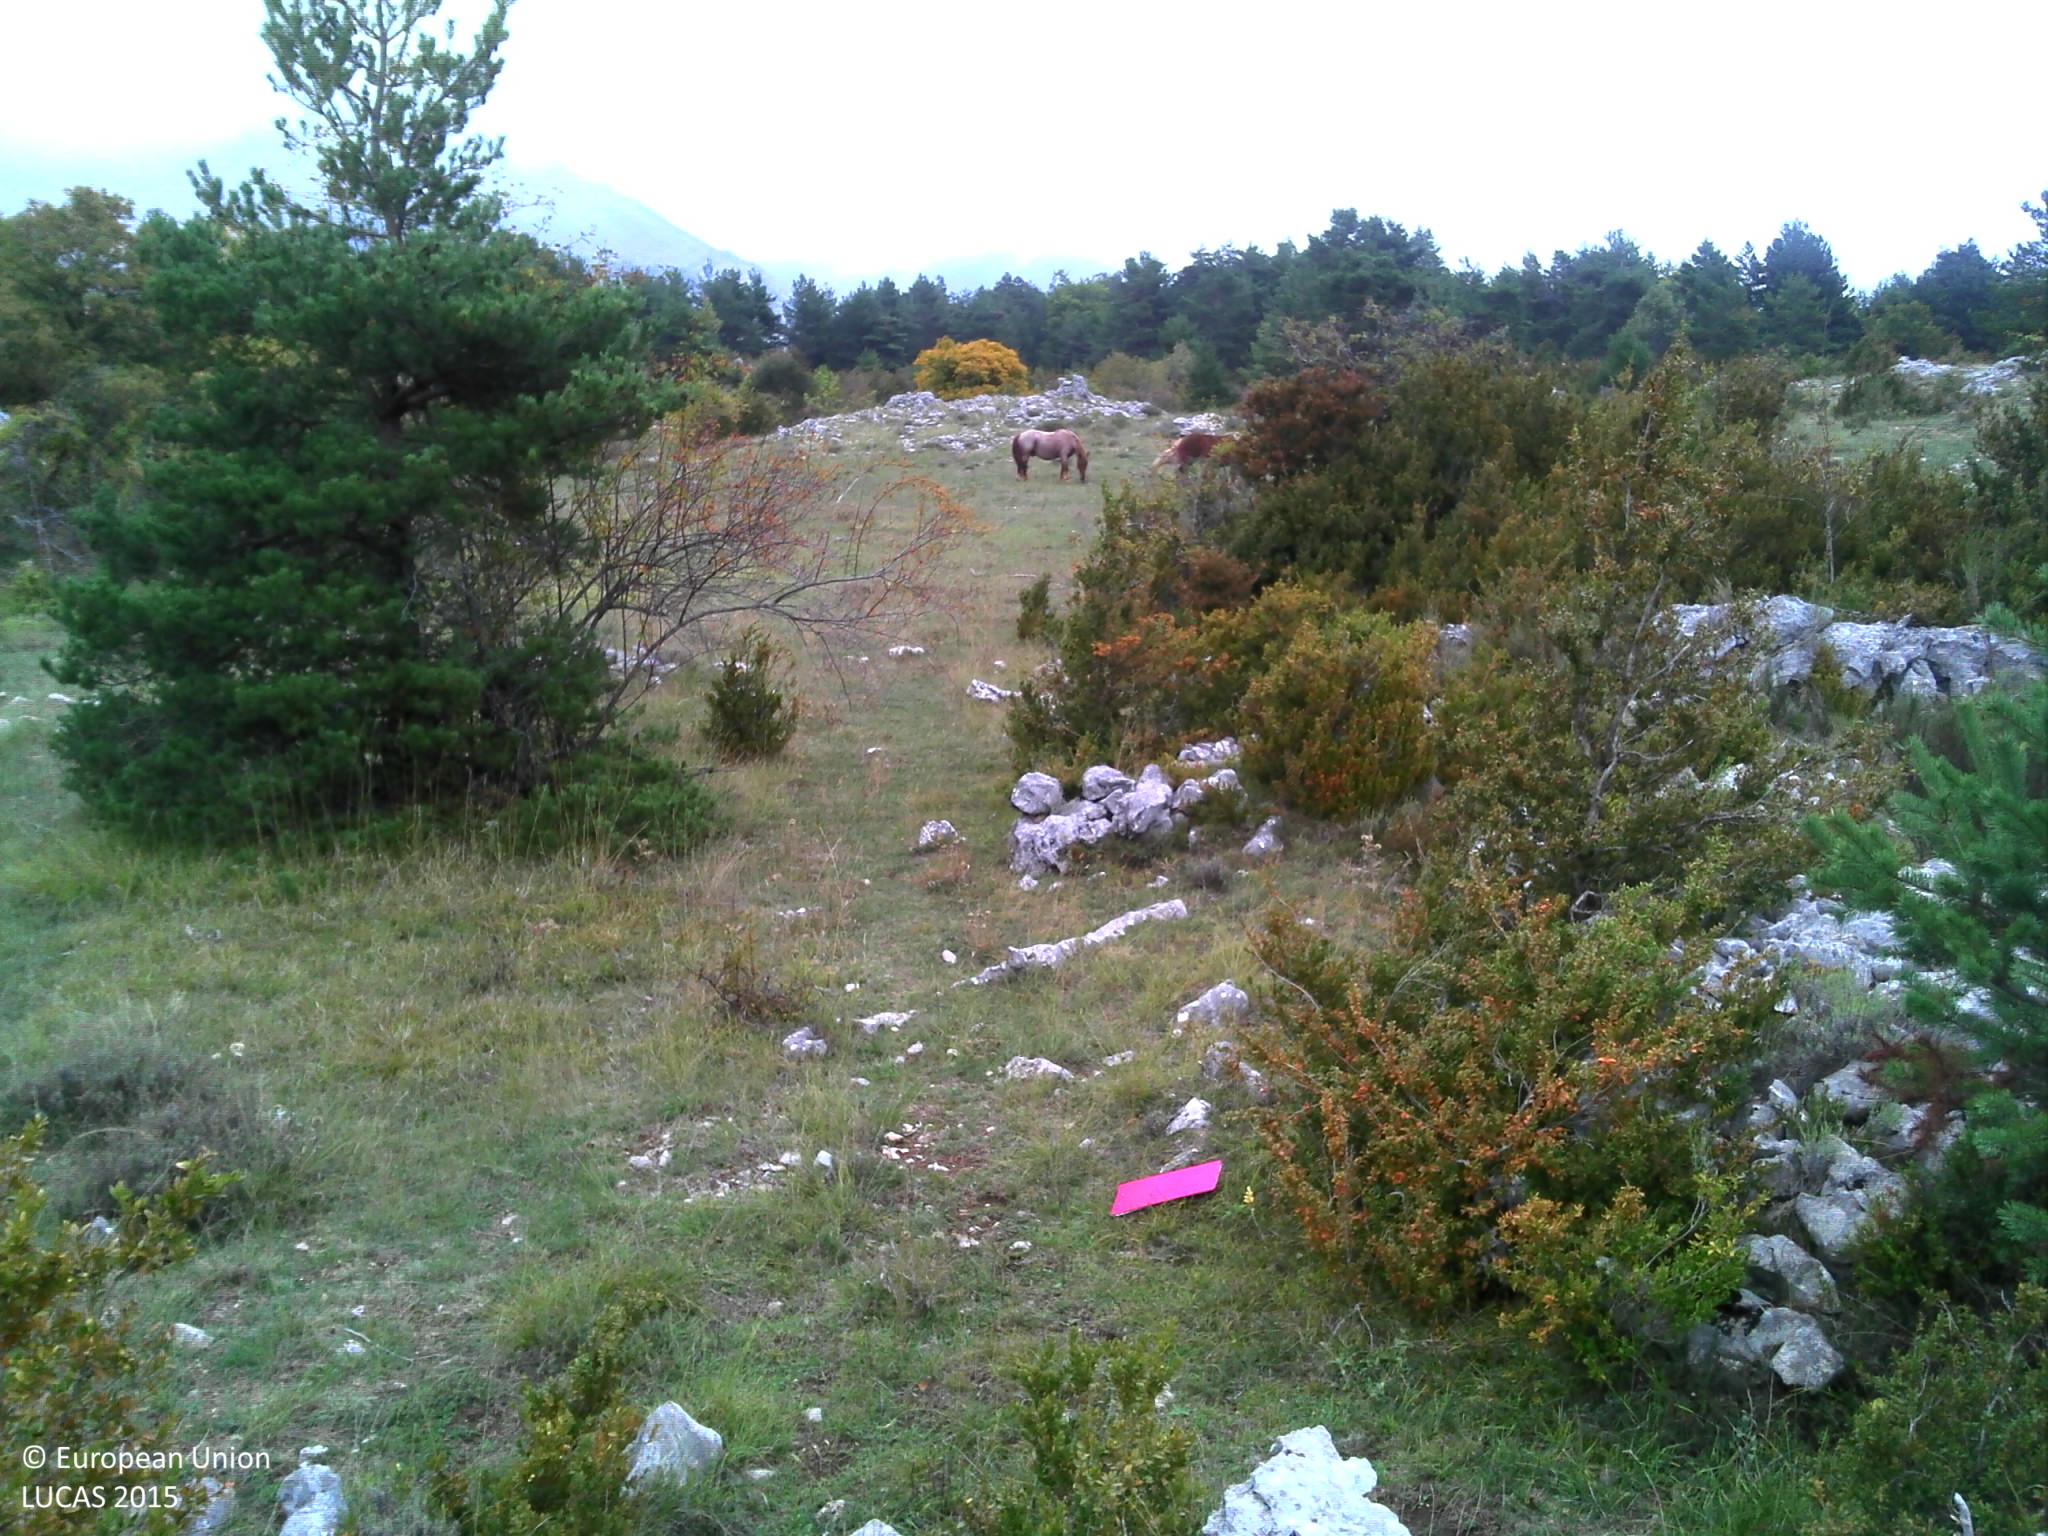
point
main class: Grassland
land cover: Grassland with sparse tree/shrub cover
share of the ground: > 75 %
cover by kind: herbaceous plants 60 %, consolidated bare surface 20 %, shrubs 10 %, coniferous forest trees 5 %, lichens and mosses 5 %
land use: Agriculture (excluding fallow land and kitchen gardens)
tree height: < 5 m
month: October
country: FR
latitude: 43.7429
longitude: 6.8410
